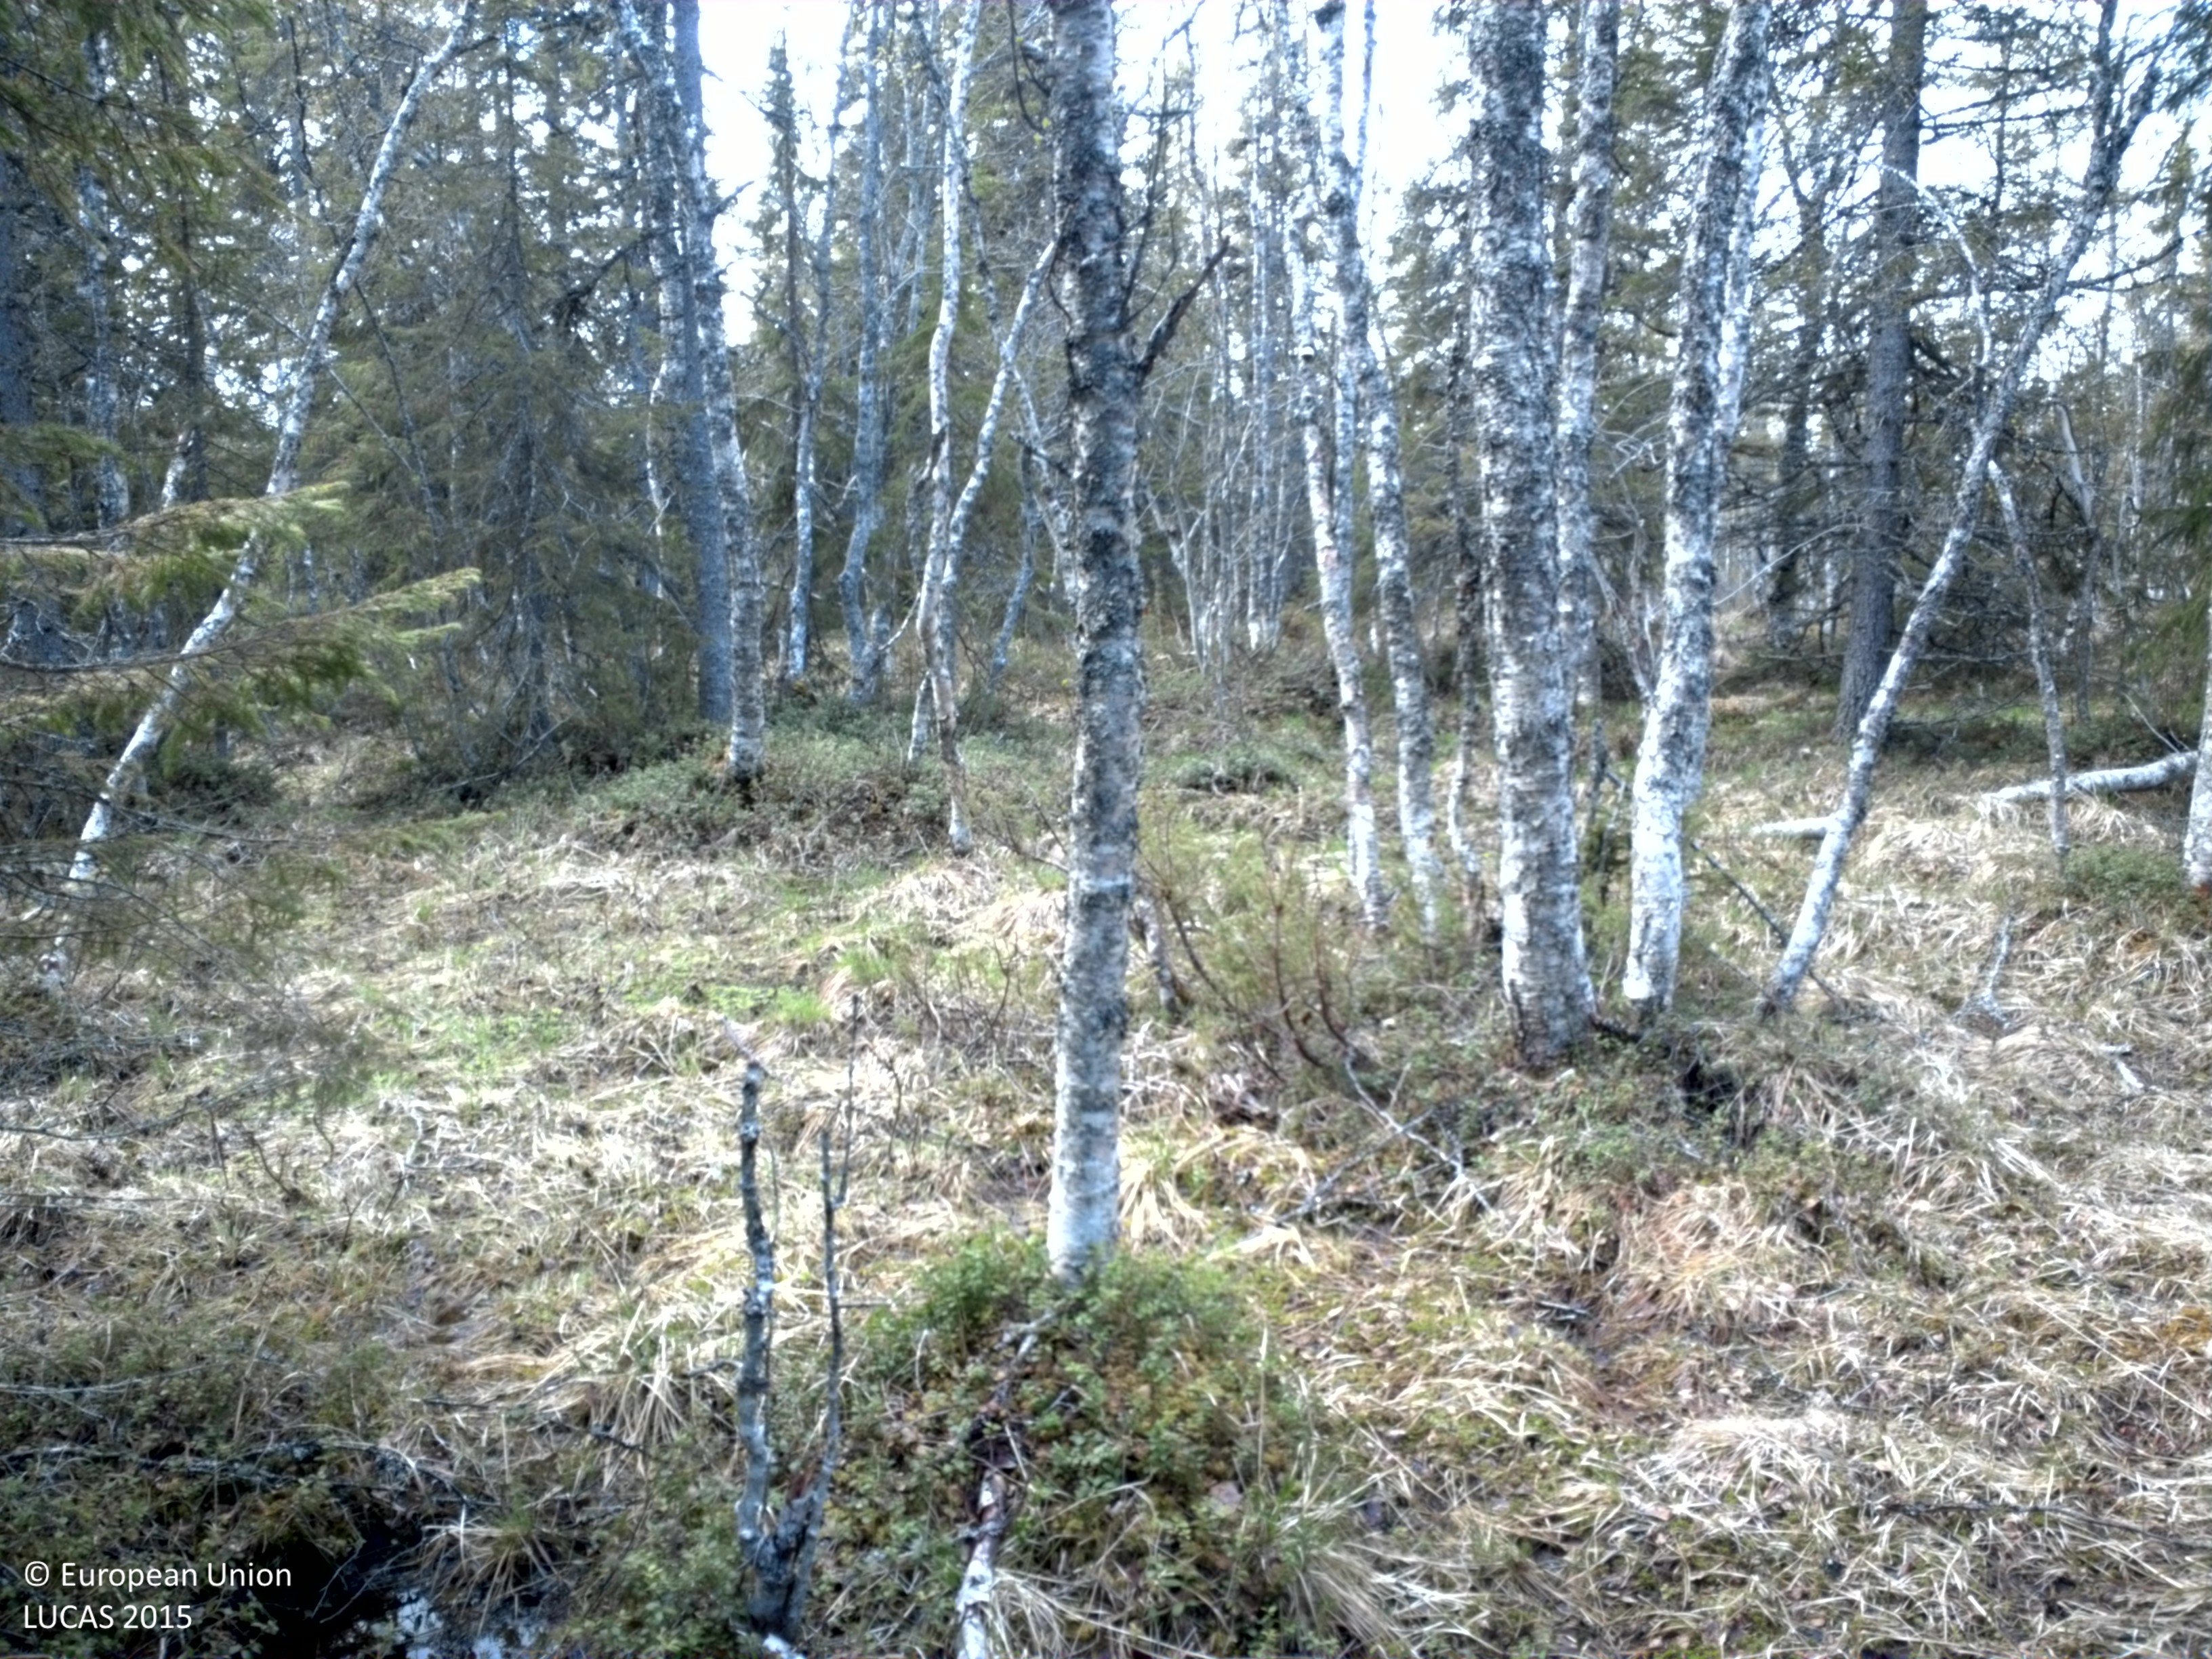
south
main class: Woodland
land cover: Spruce dominated mixed woodland
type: boreal forest
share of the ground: > 75 %
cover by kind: coniferous forest trees 65 %, broadleaved forest trees 25 %, shrubs 10 %
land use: Forestry
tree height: > 5 m
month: June
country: SE
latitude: 63.5218
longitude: 13.7799
